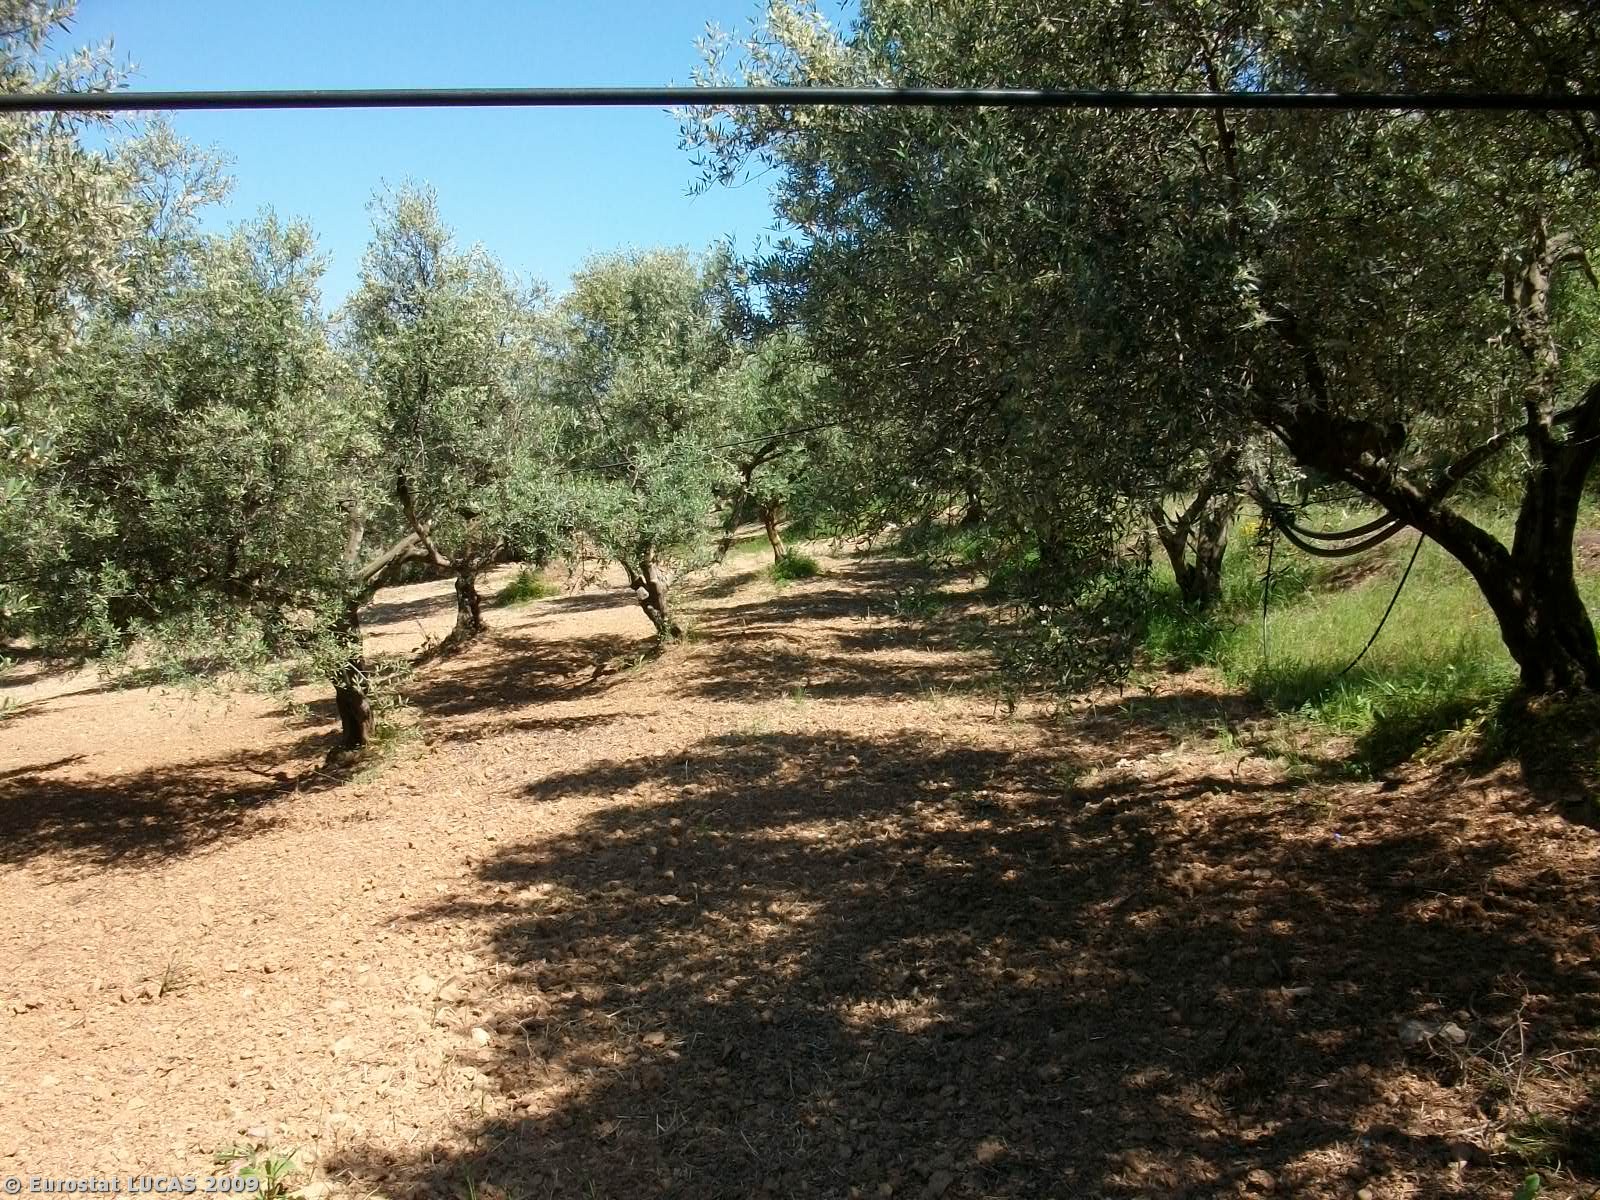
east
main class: Cropland
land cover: Olive groves
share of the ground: 50 - 75 %
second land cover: Bare land
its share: > 75 %
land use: Agriculture (excluding fallow land and kitchen gardens)
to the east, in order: Olive groves; Bare land; Fences; Olive groves; Bare land; Electric lines; Olive groves; Bare land; Rivers and streams; Olive groves; Bare land
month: May
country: GR
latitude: 35.4721
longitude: 23.7699
